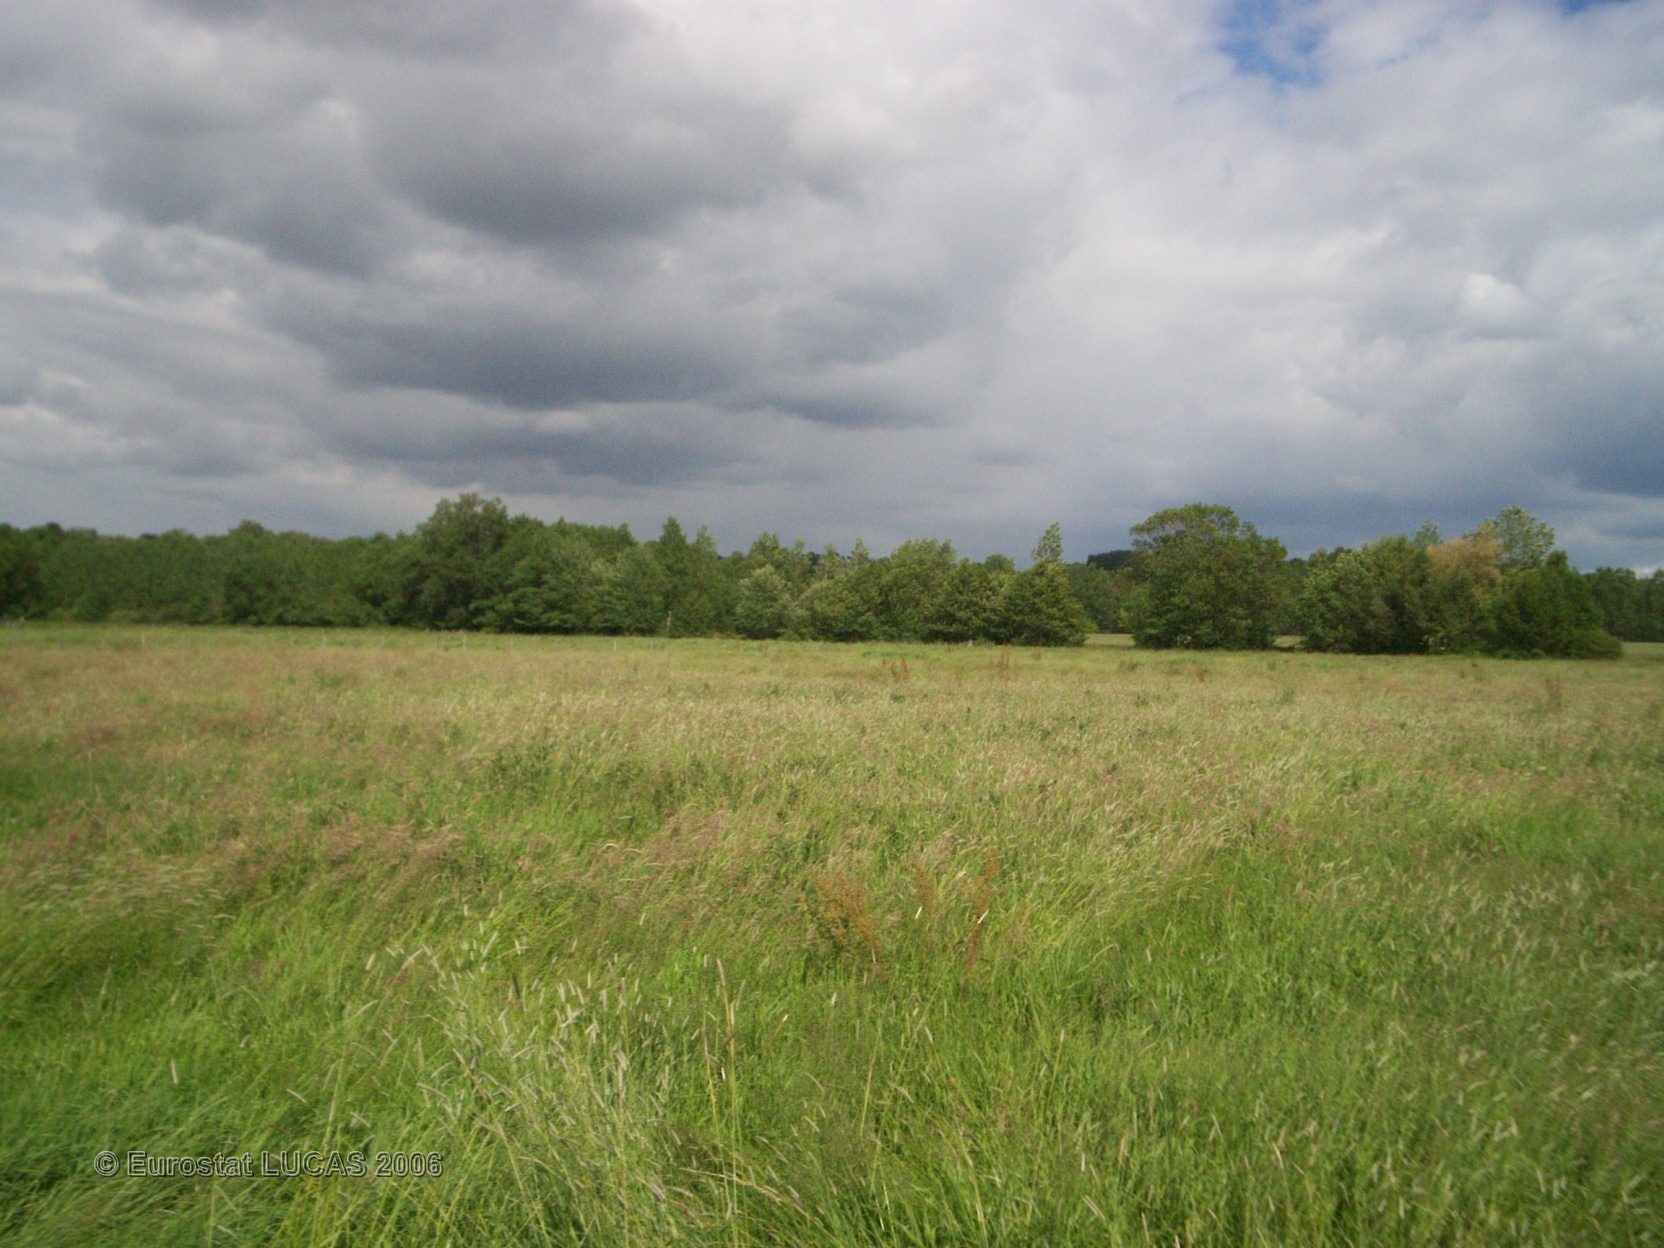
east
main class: Grassland
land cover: Grassland without tree/shrub cover
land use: Agriculture (excluding fallow land and kitchen gardens)
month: May
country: FR
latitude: 47.0641
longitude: 1.5215
